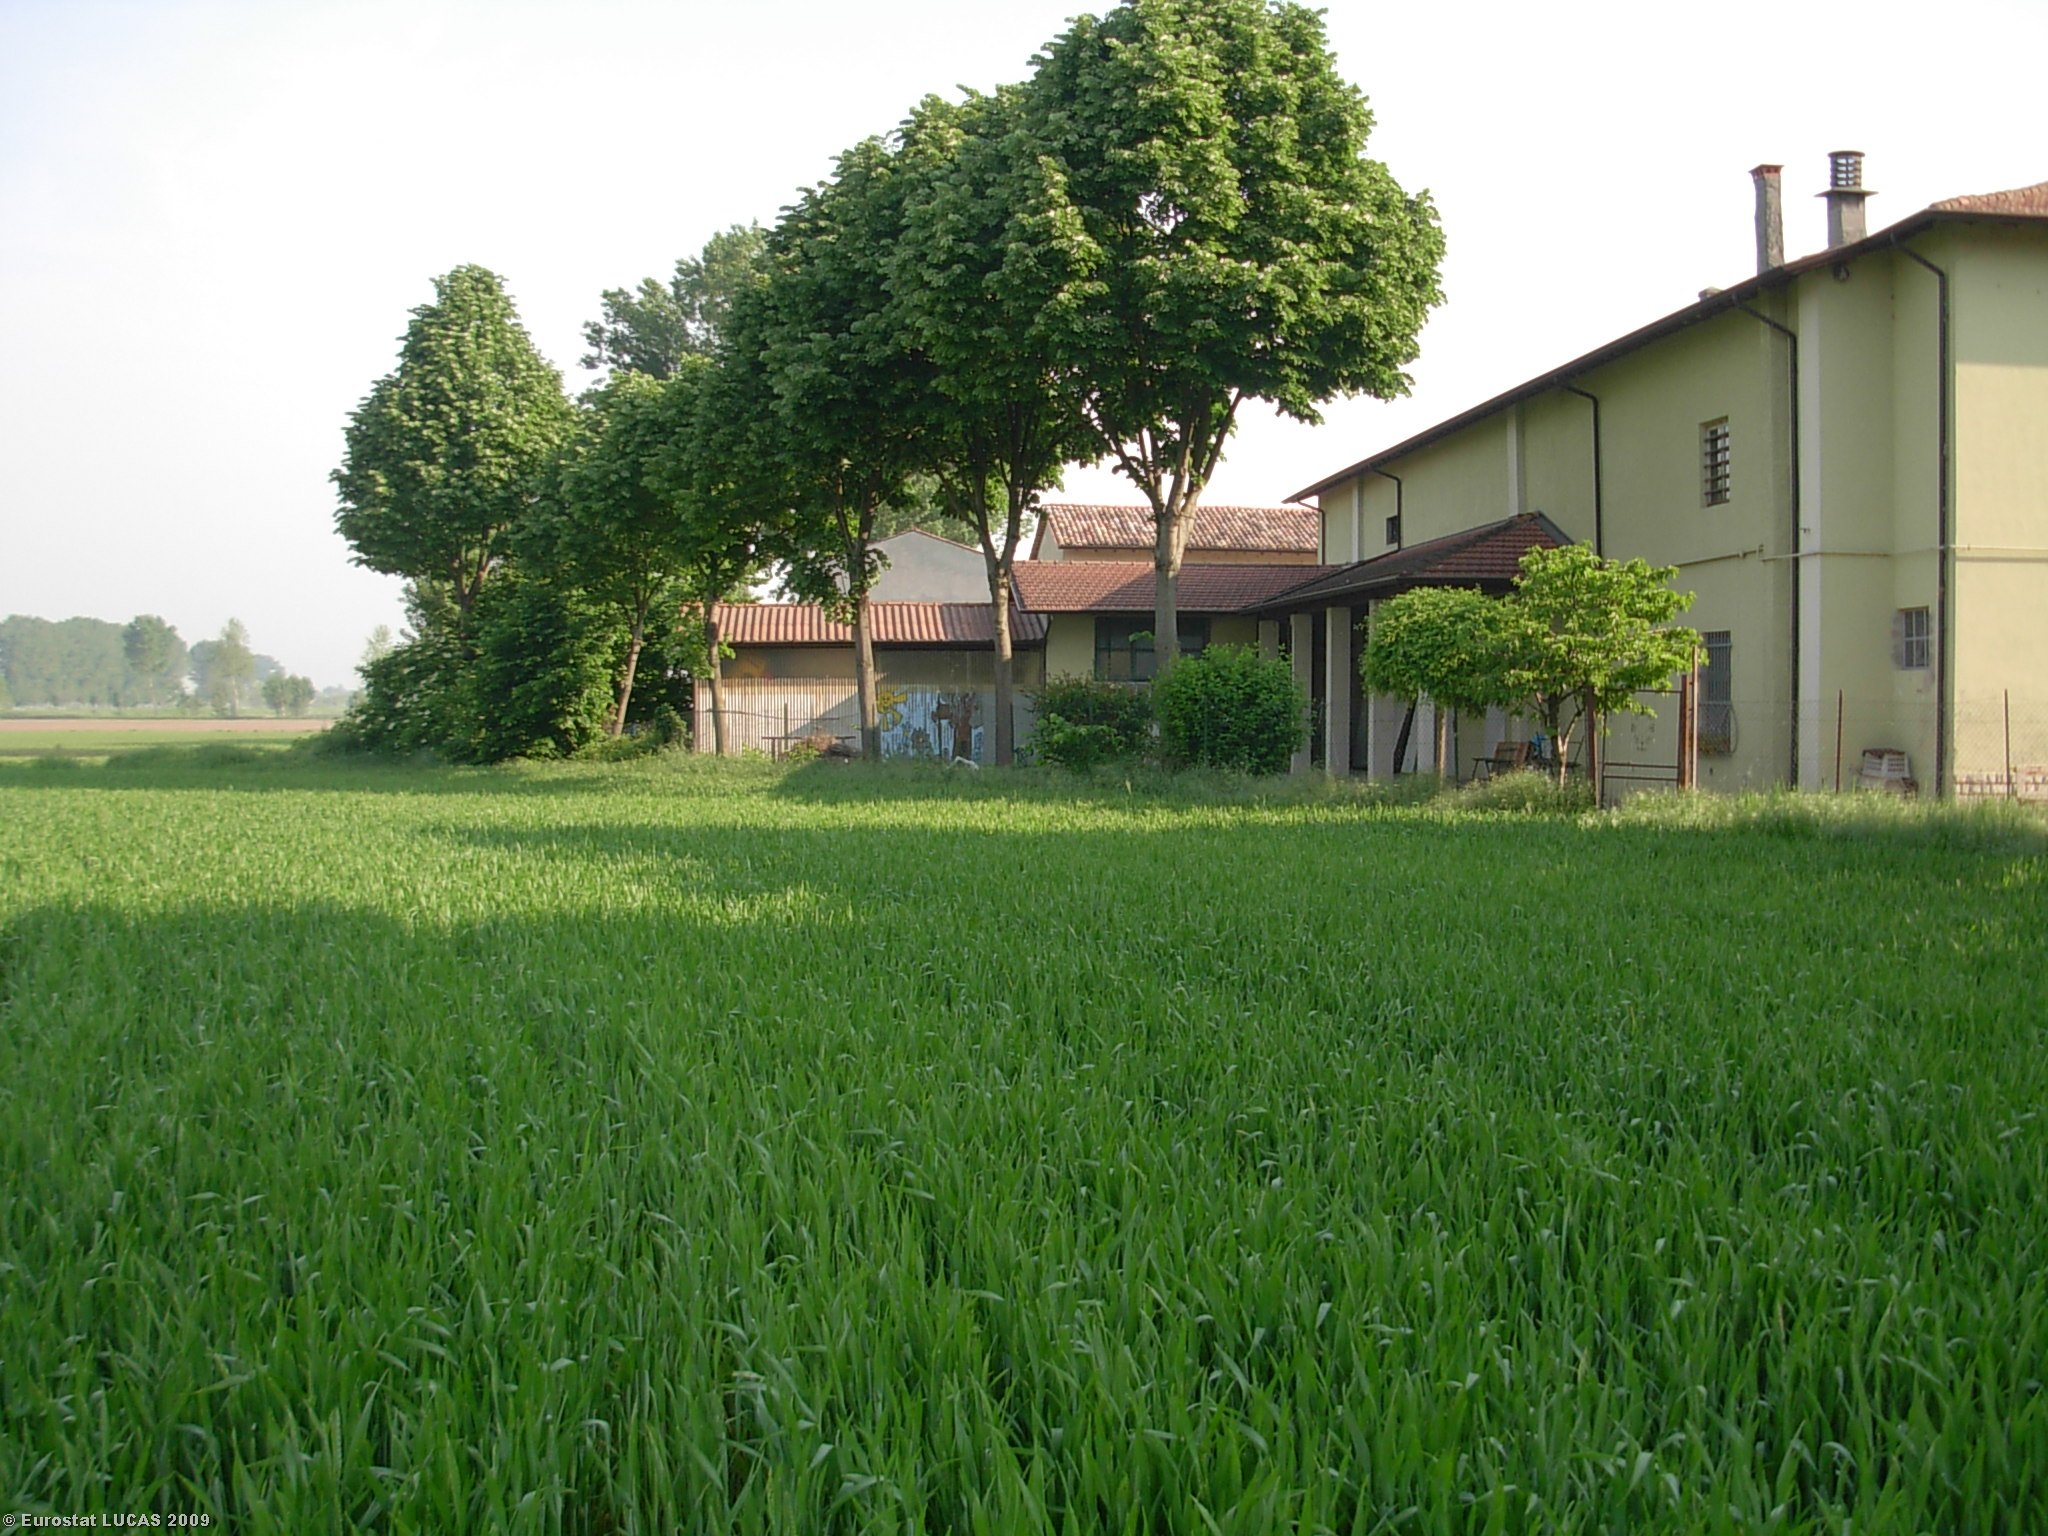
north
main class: Cropland
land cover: Common wheat
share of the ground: > 75 %
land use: Agriculture (excluding fallow land and kitchen gardens)
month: May
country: IT
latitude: 45.2336
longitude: 10.3178
